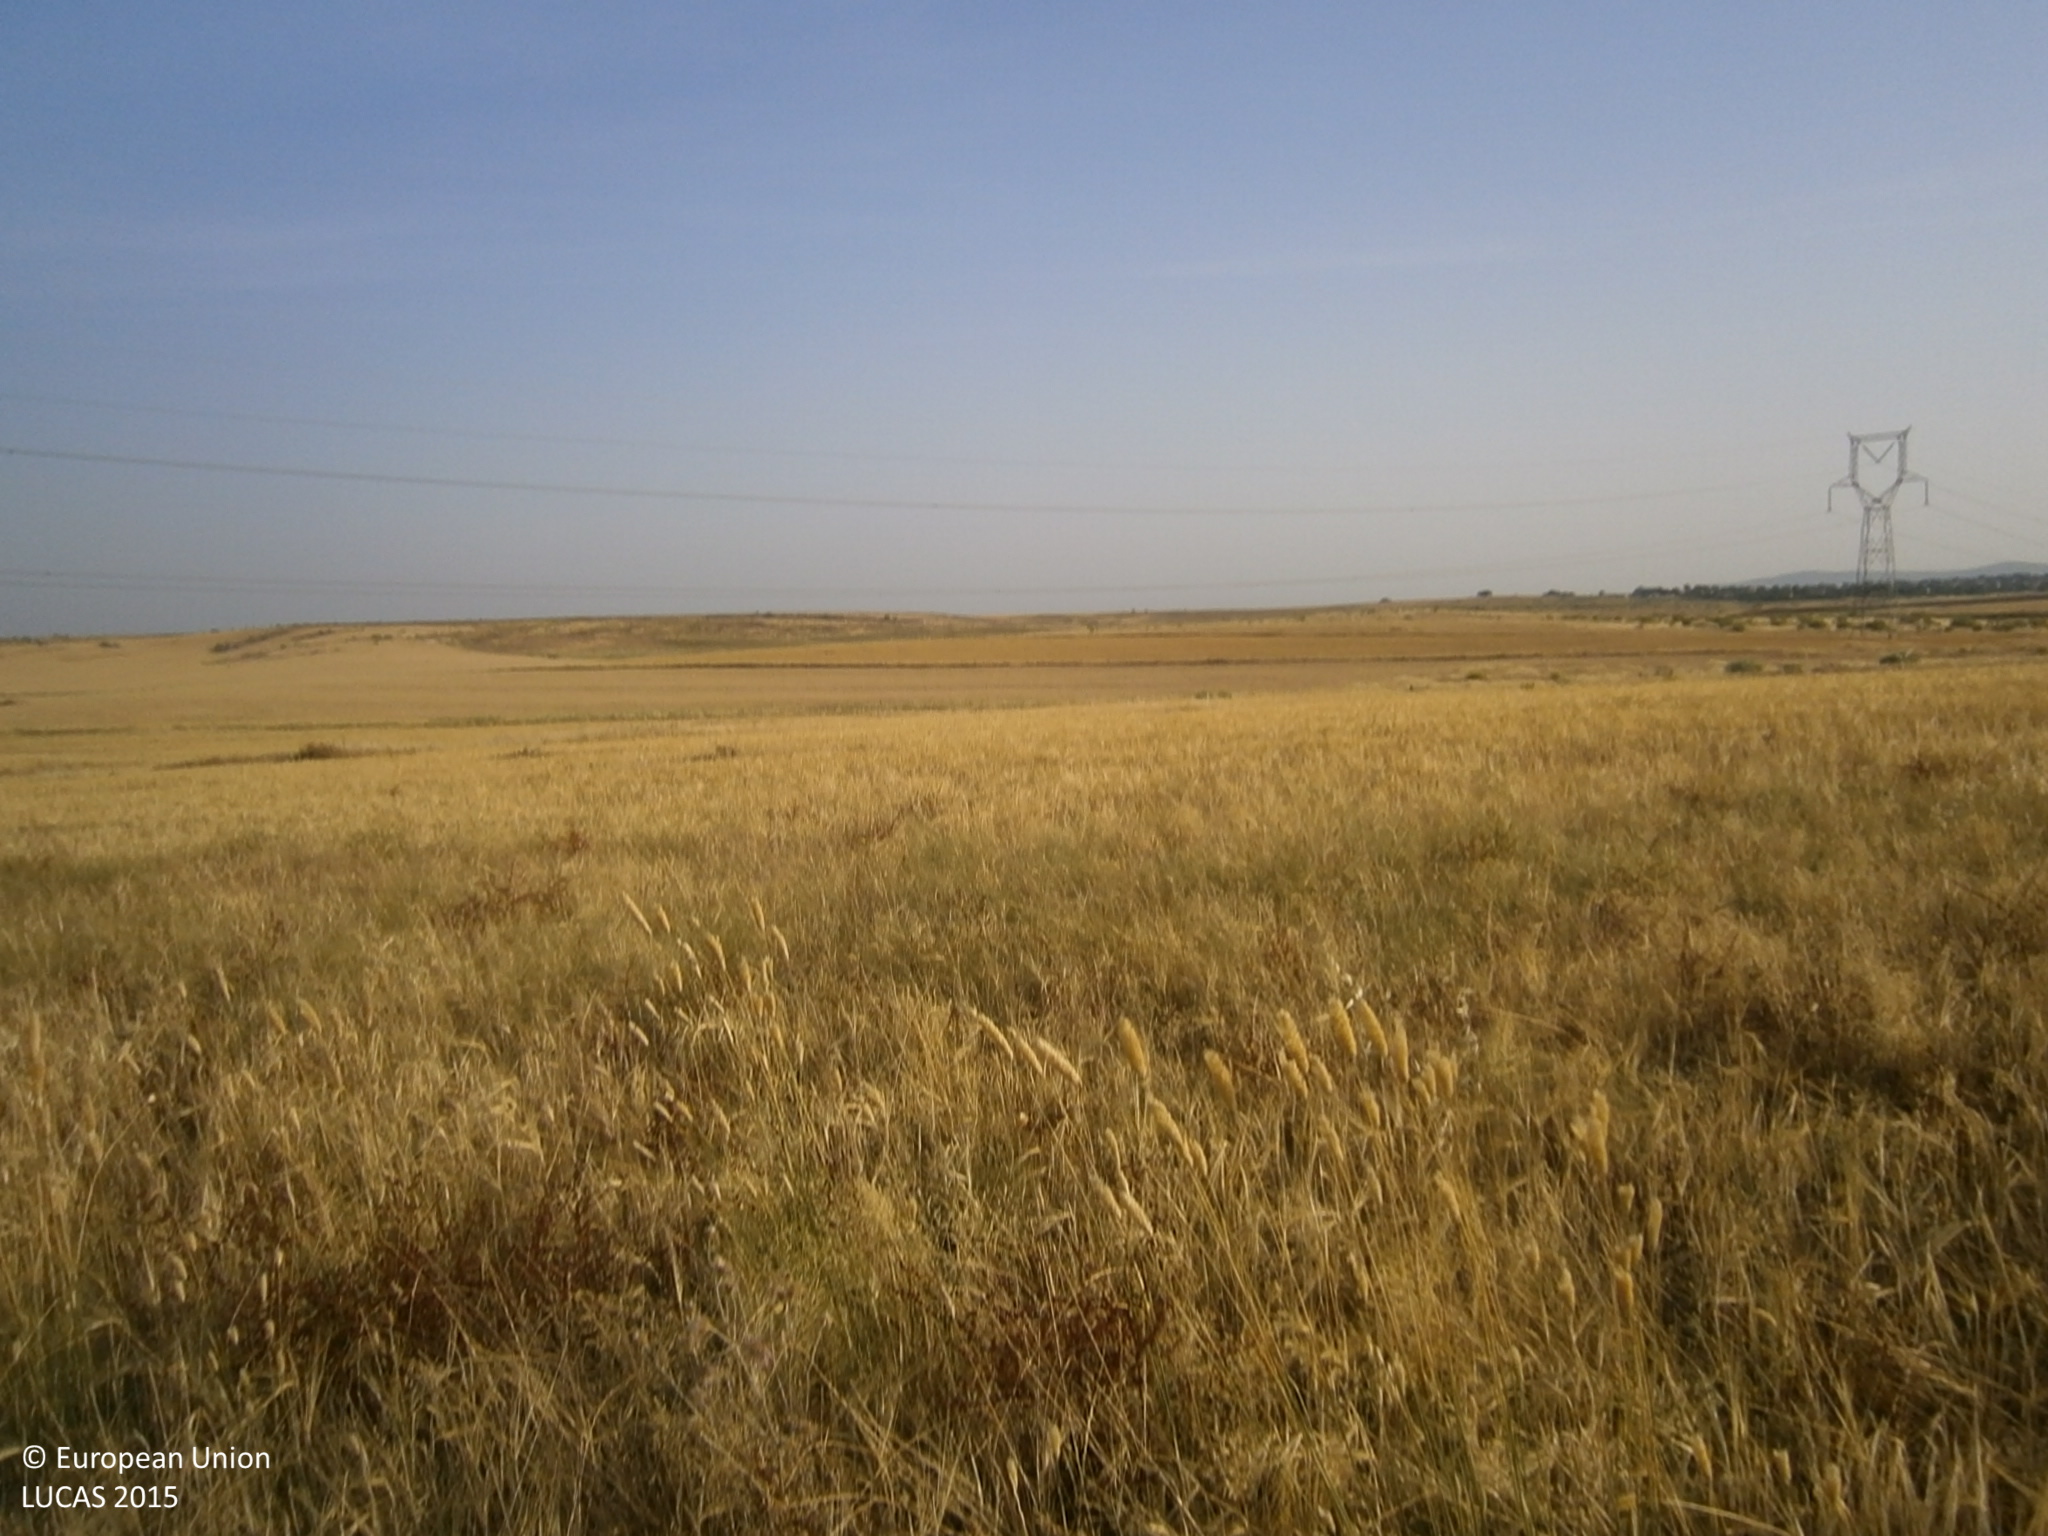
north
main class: Grassland
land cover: Grassland without tree/shrub cover
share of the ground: > 75 %
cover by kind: herbaceous plants 100 %
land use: Agriculture (excluding fallow land and kitchen gardens)
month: June
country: ES
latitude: 38.9013
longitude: -6.2563
